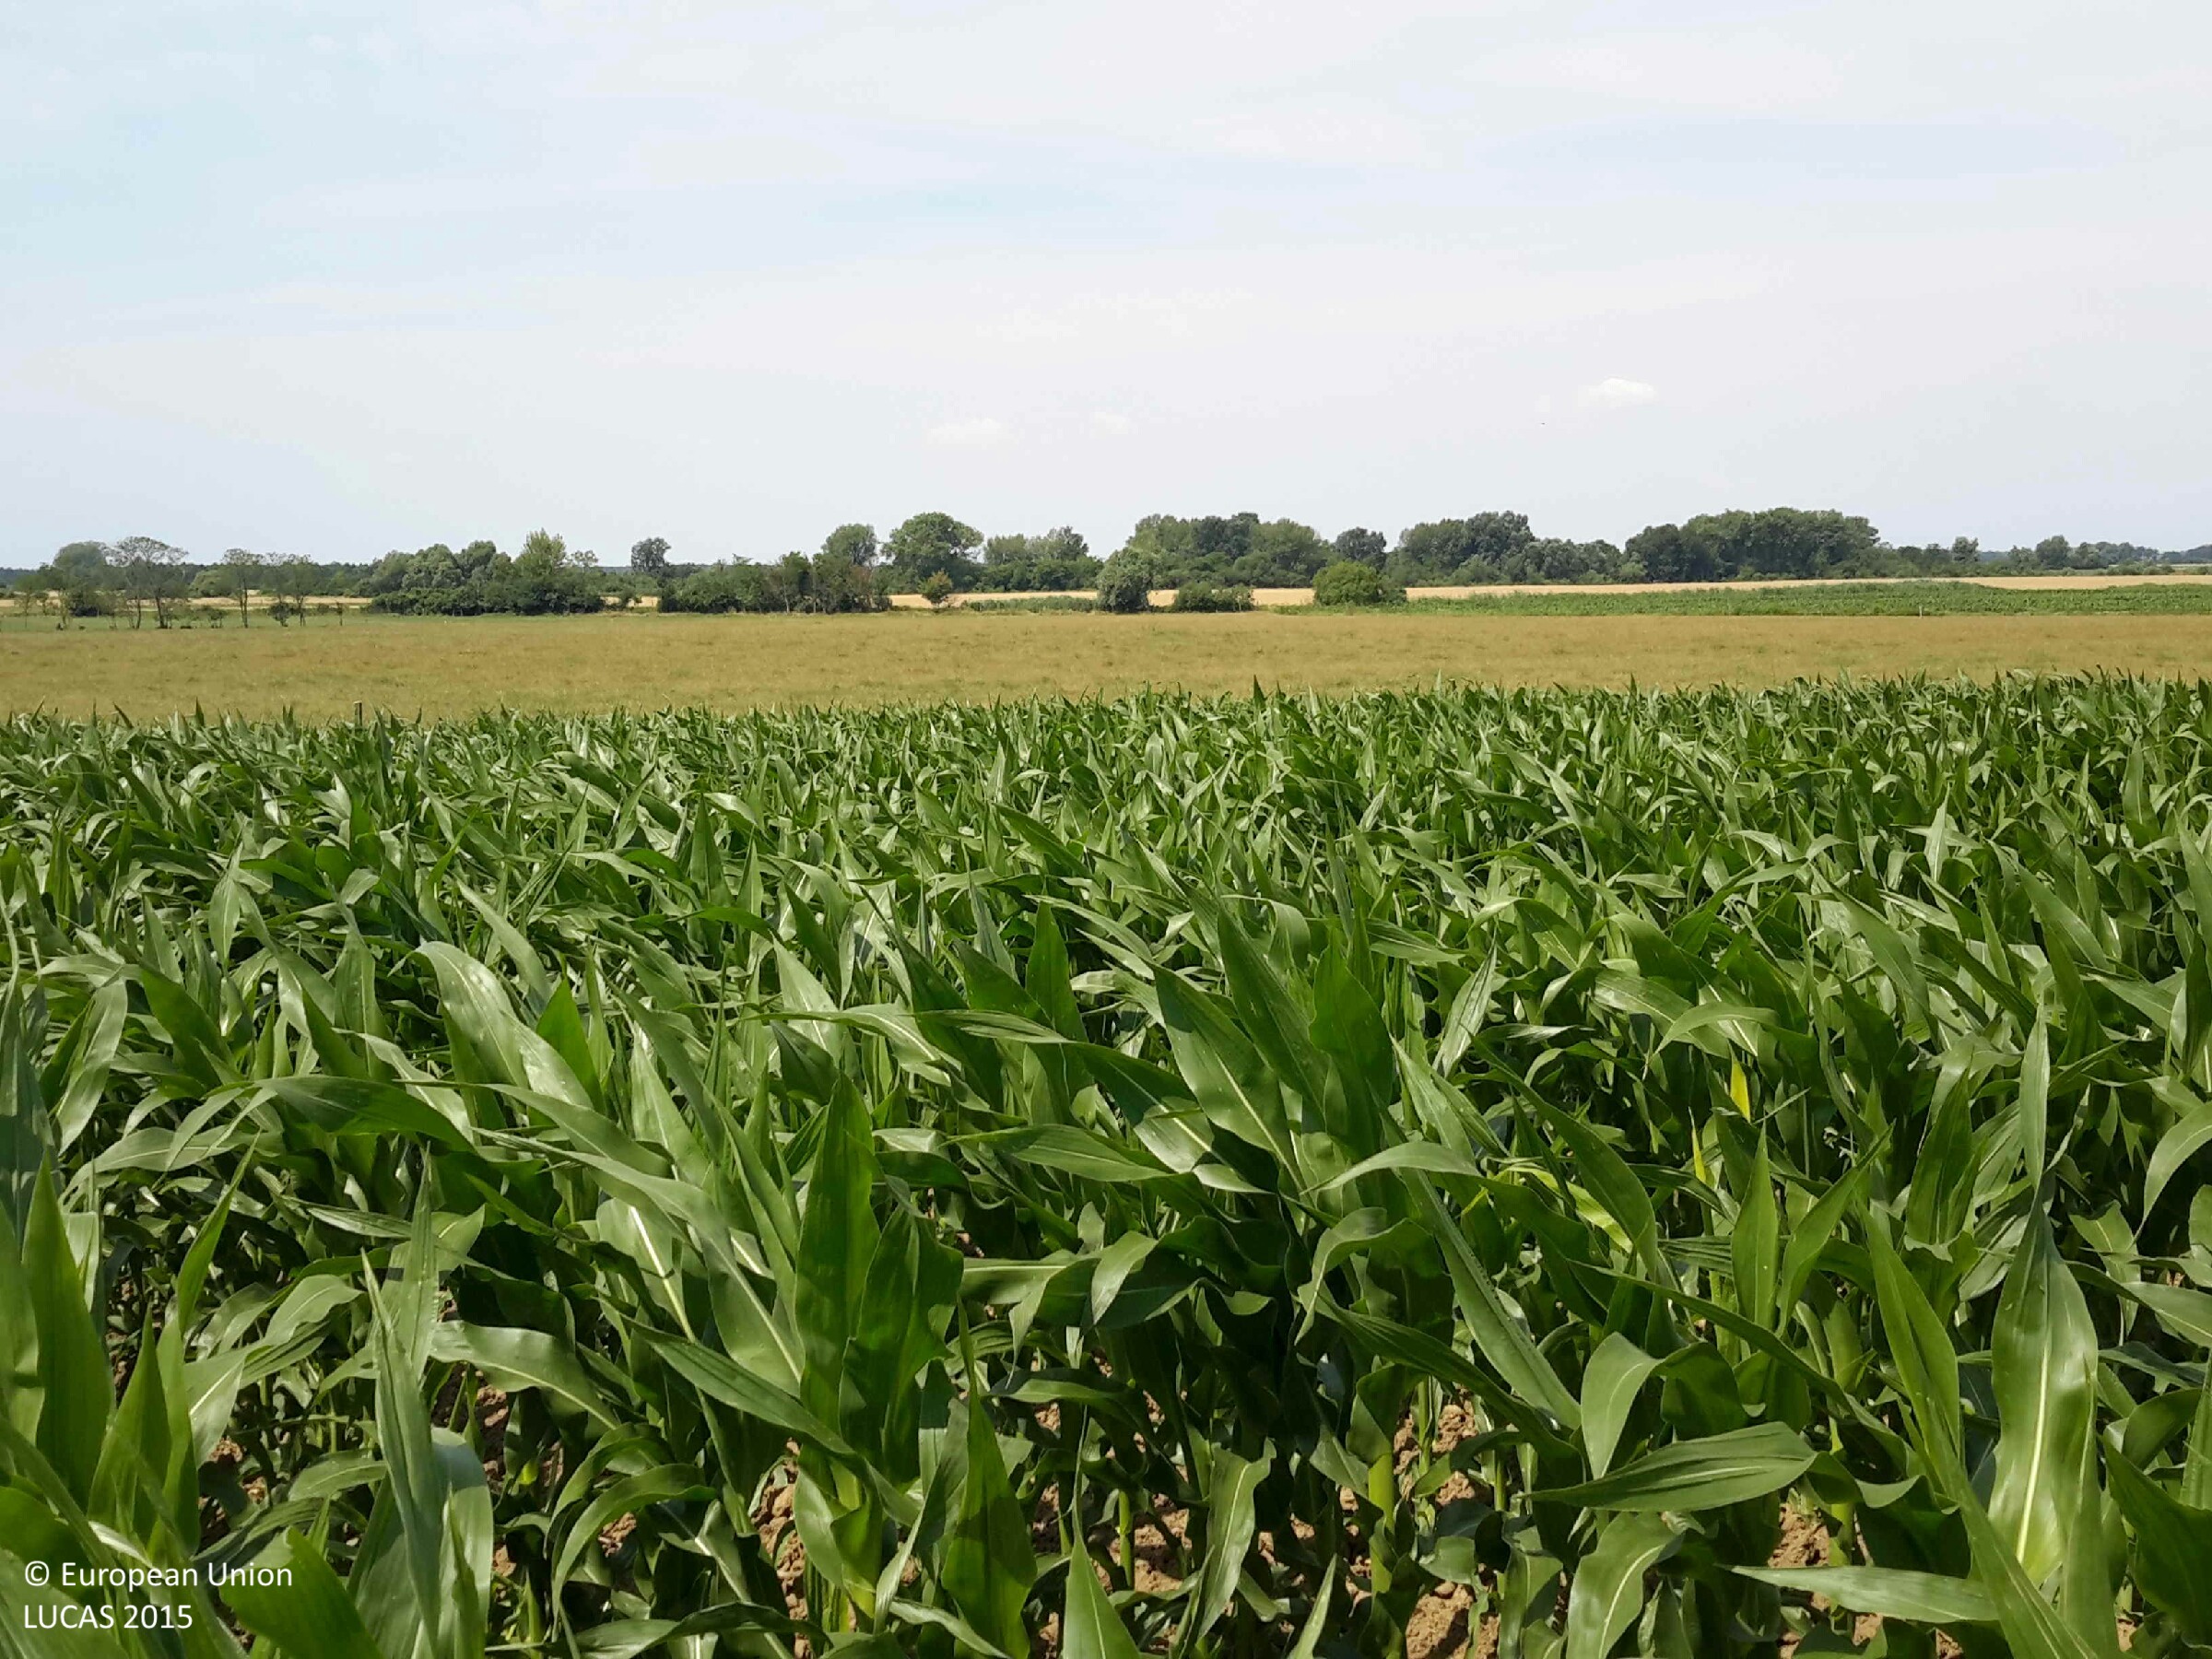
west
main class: Cropland
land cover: Maize
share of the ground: 50 - 75 %
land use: Agriculture (excluding fallow land and kitchen gardens)
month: June
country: HU
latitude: 47.2666
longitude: 17.4482
